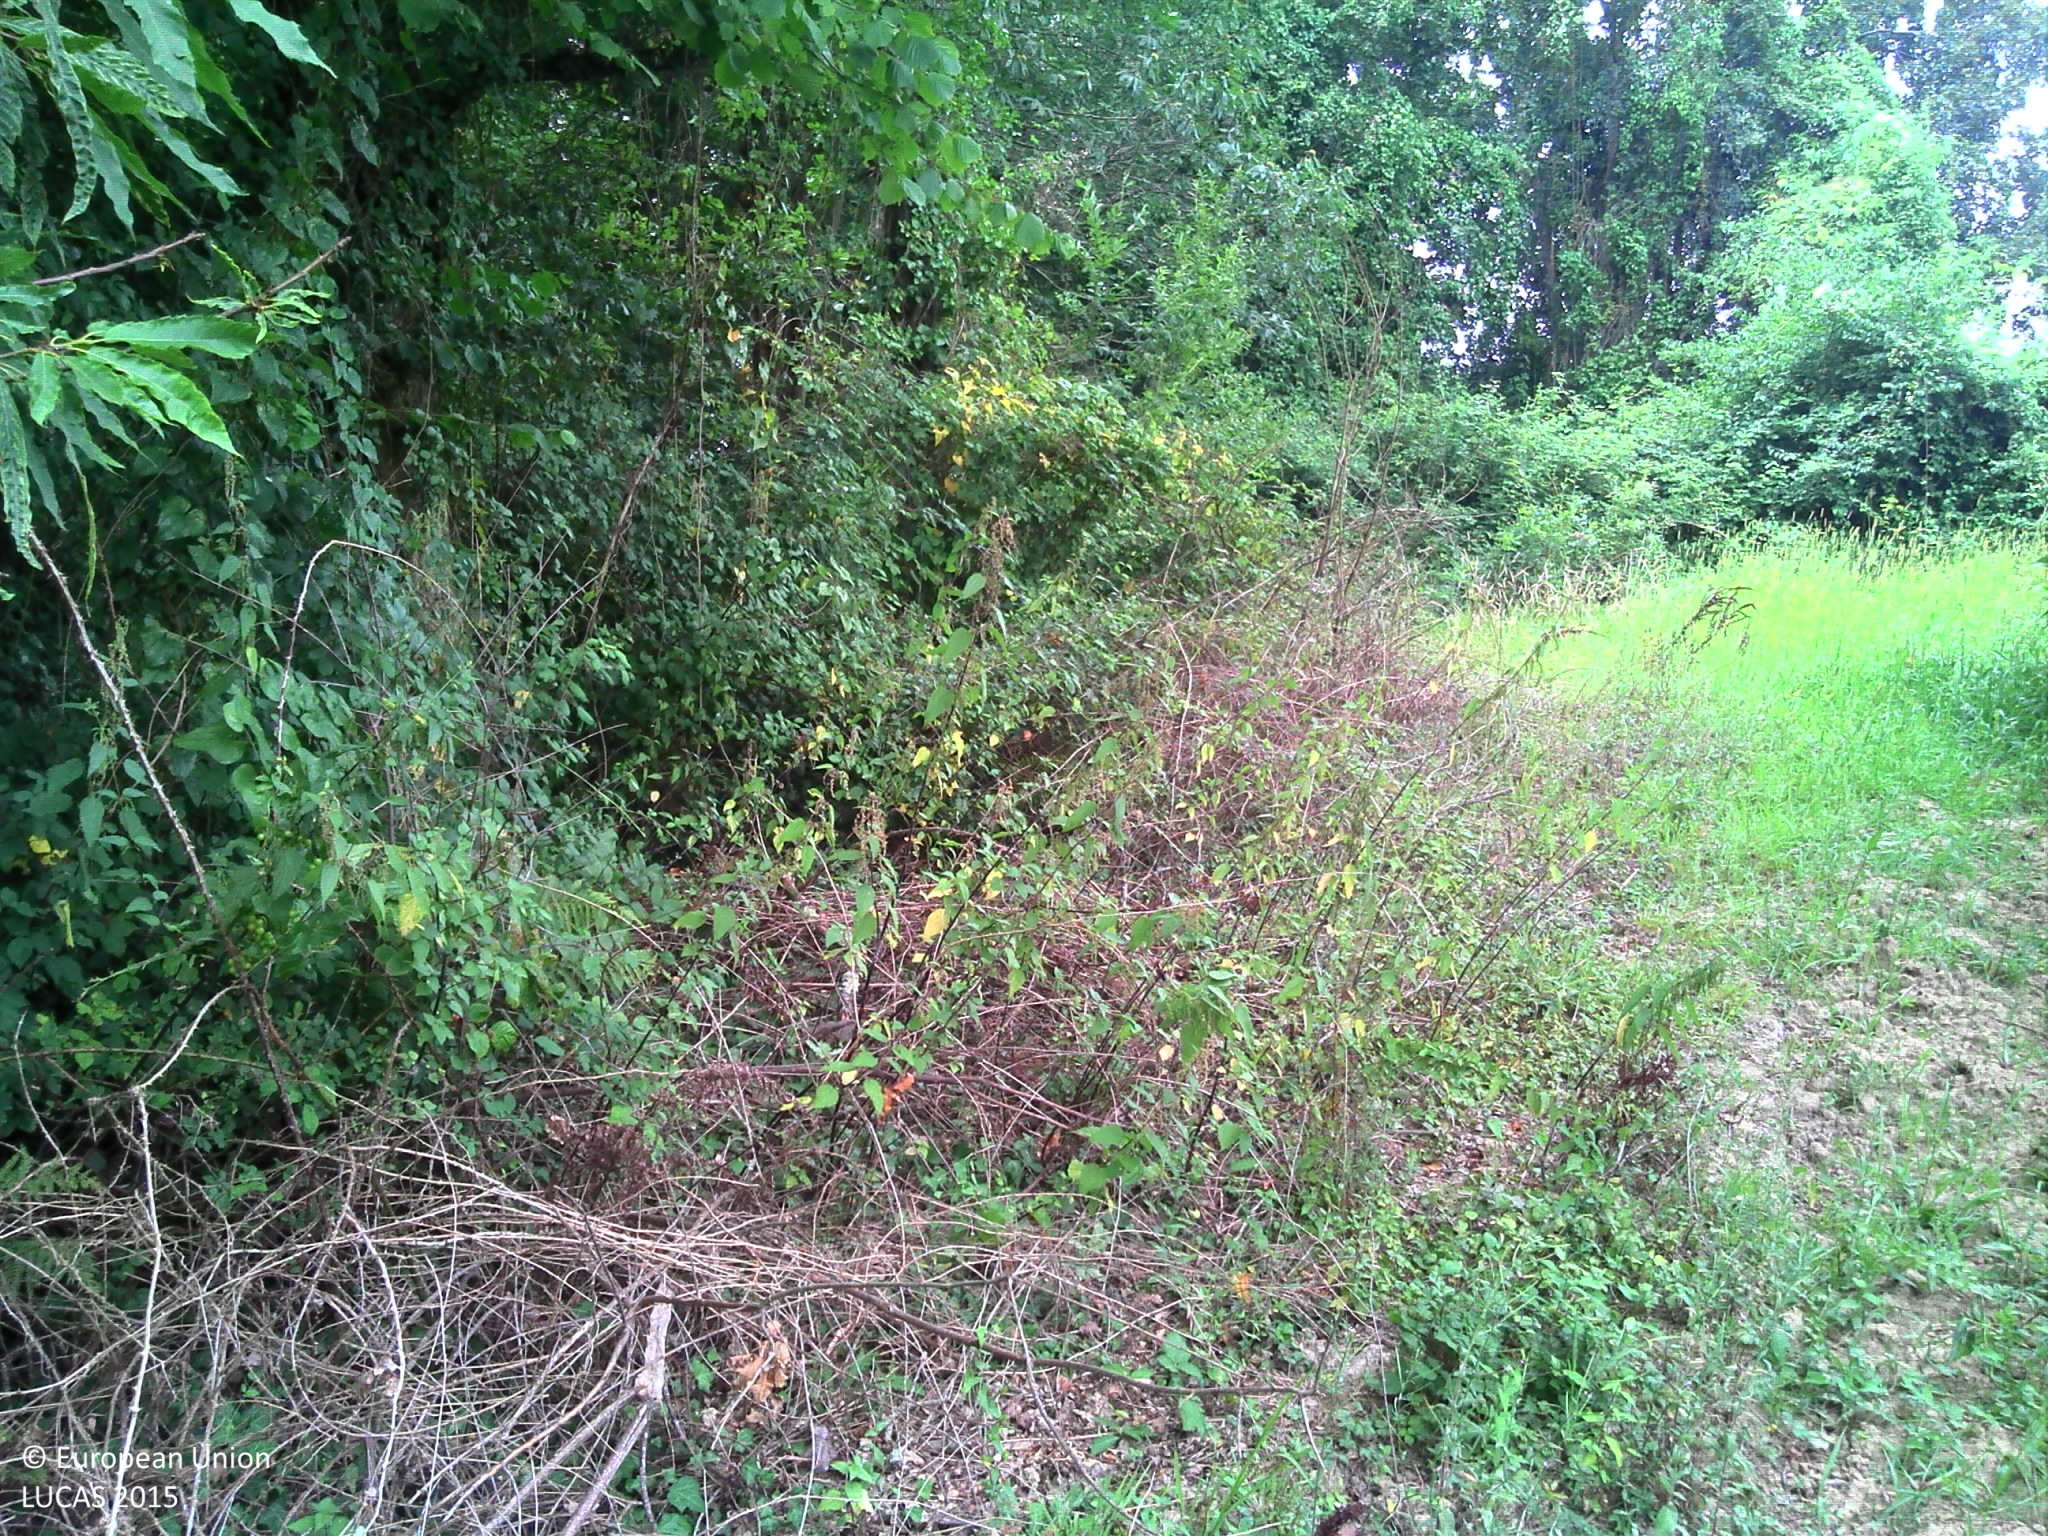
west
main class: Cropland
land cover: Maize
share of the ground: > 75 %
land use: Agriculture (excluding fallow land and kitchen gardens)
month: August
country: FR
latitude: 43.4824
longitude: -1.0800
